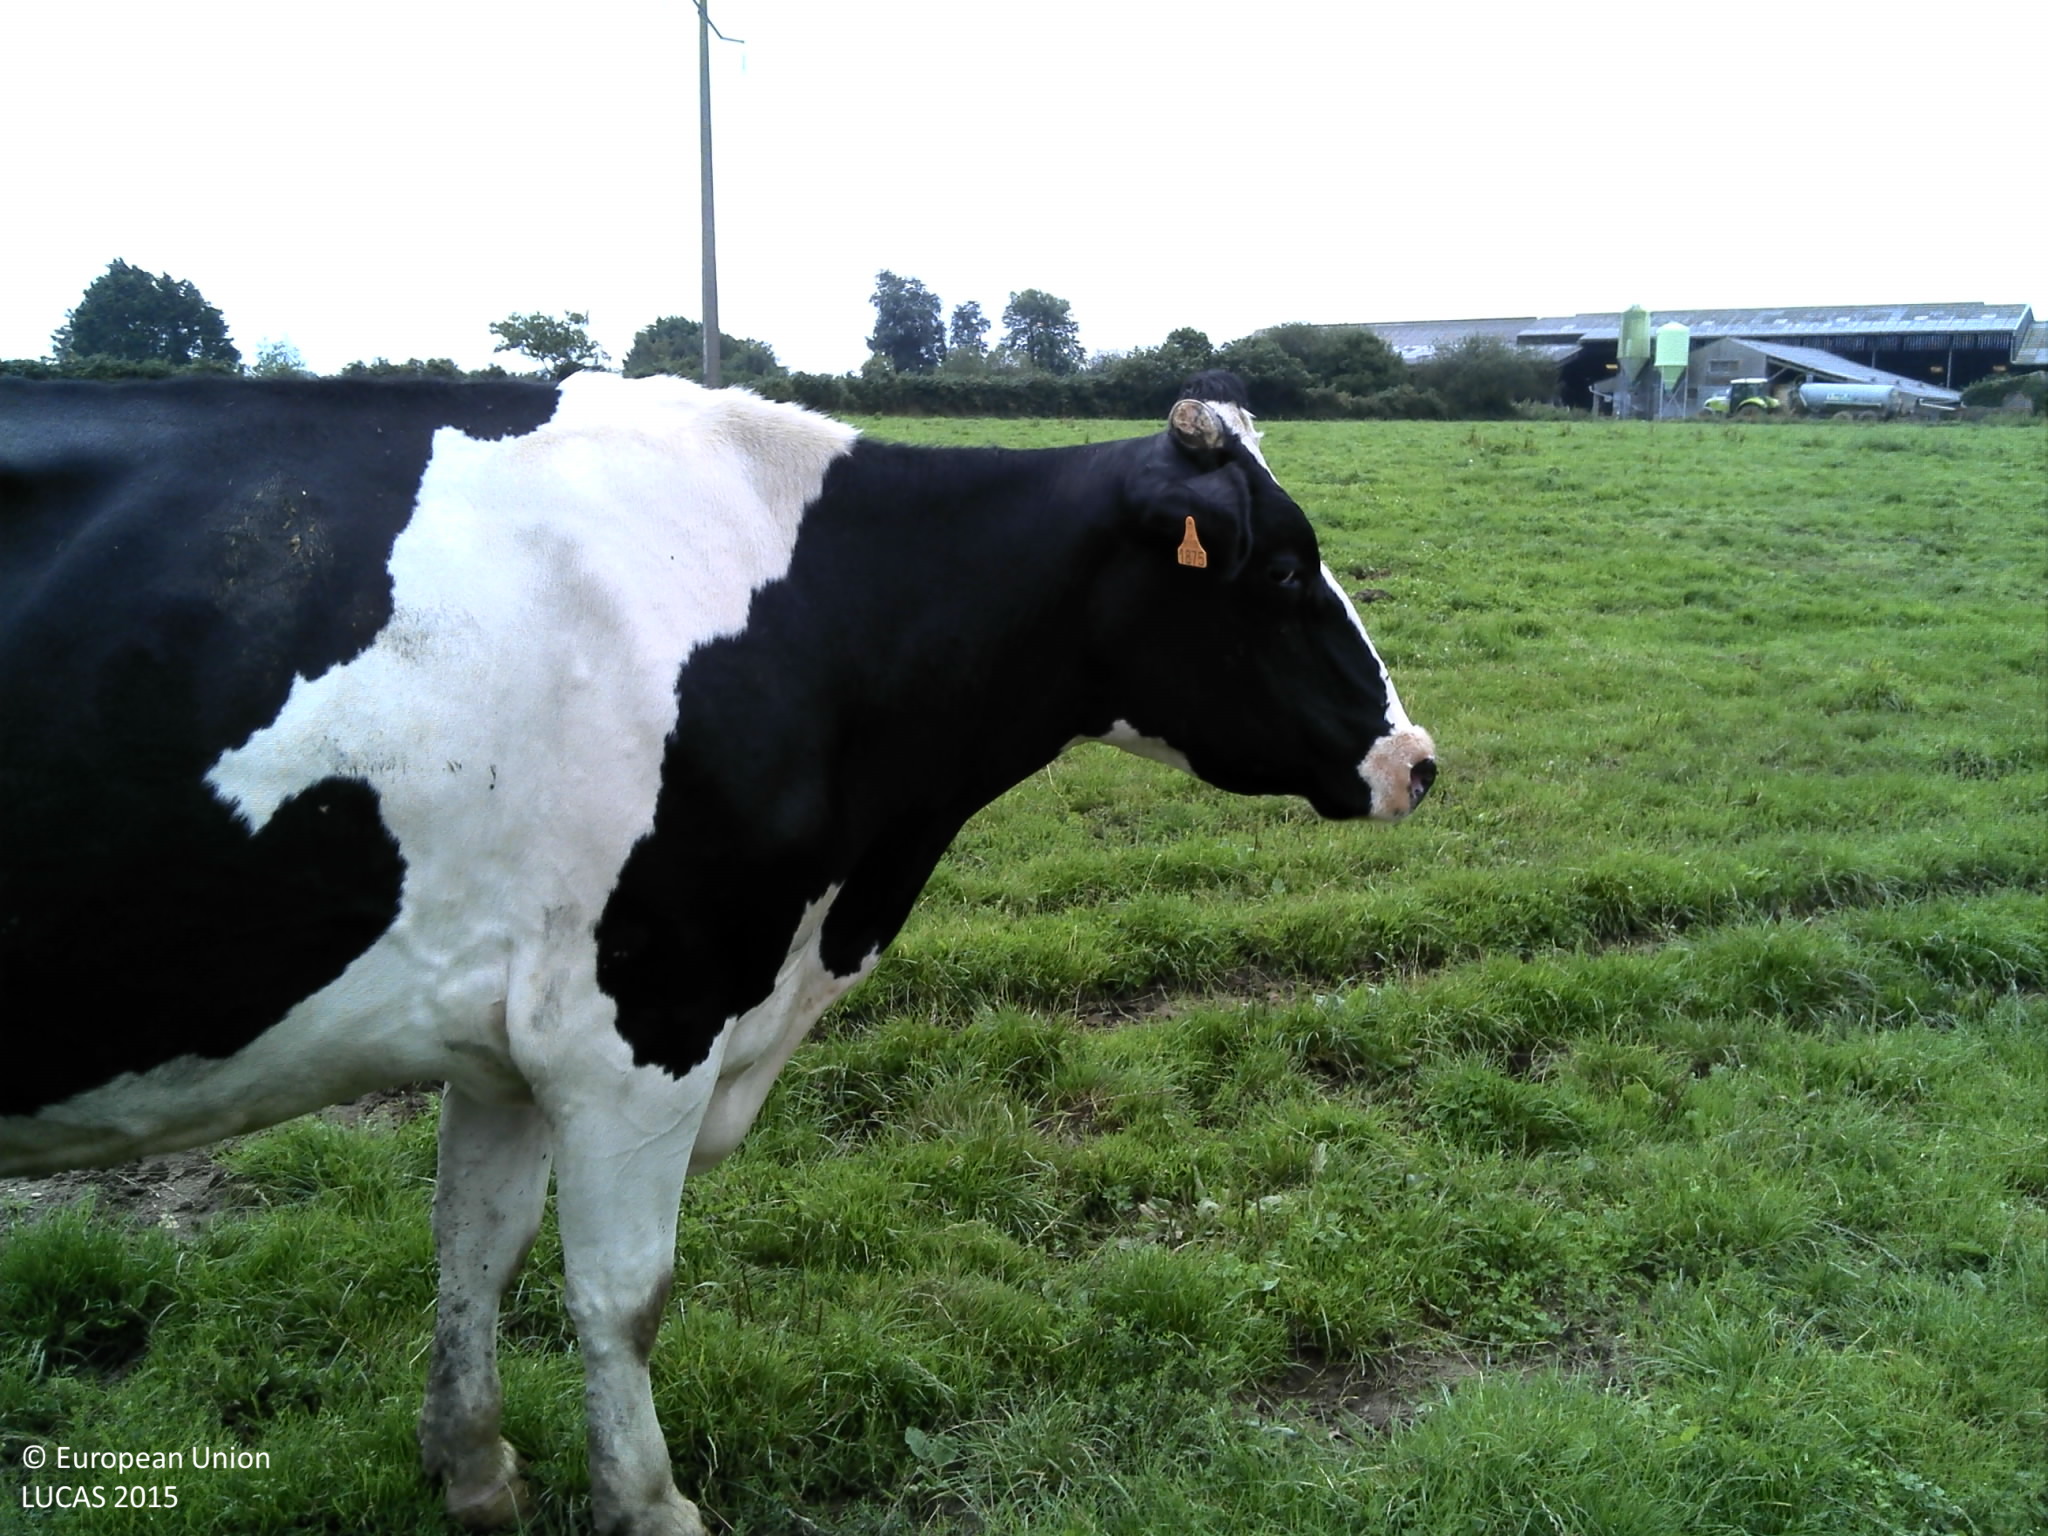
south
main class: Grassland
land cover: Grassland without tree/shrub cover
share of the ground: > 75 %
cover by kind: herbaceous plants 100 %
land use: Agriculture (excluding fallow land and kitchen gardens)
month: August
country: FR
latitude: 48.5488
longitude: -4.2780
